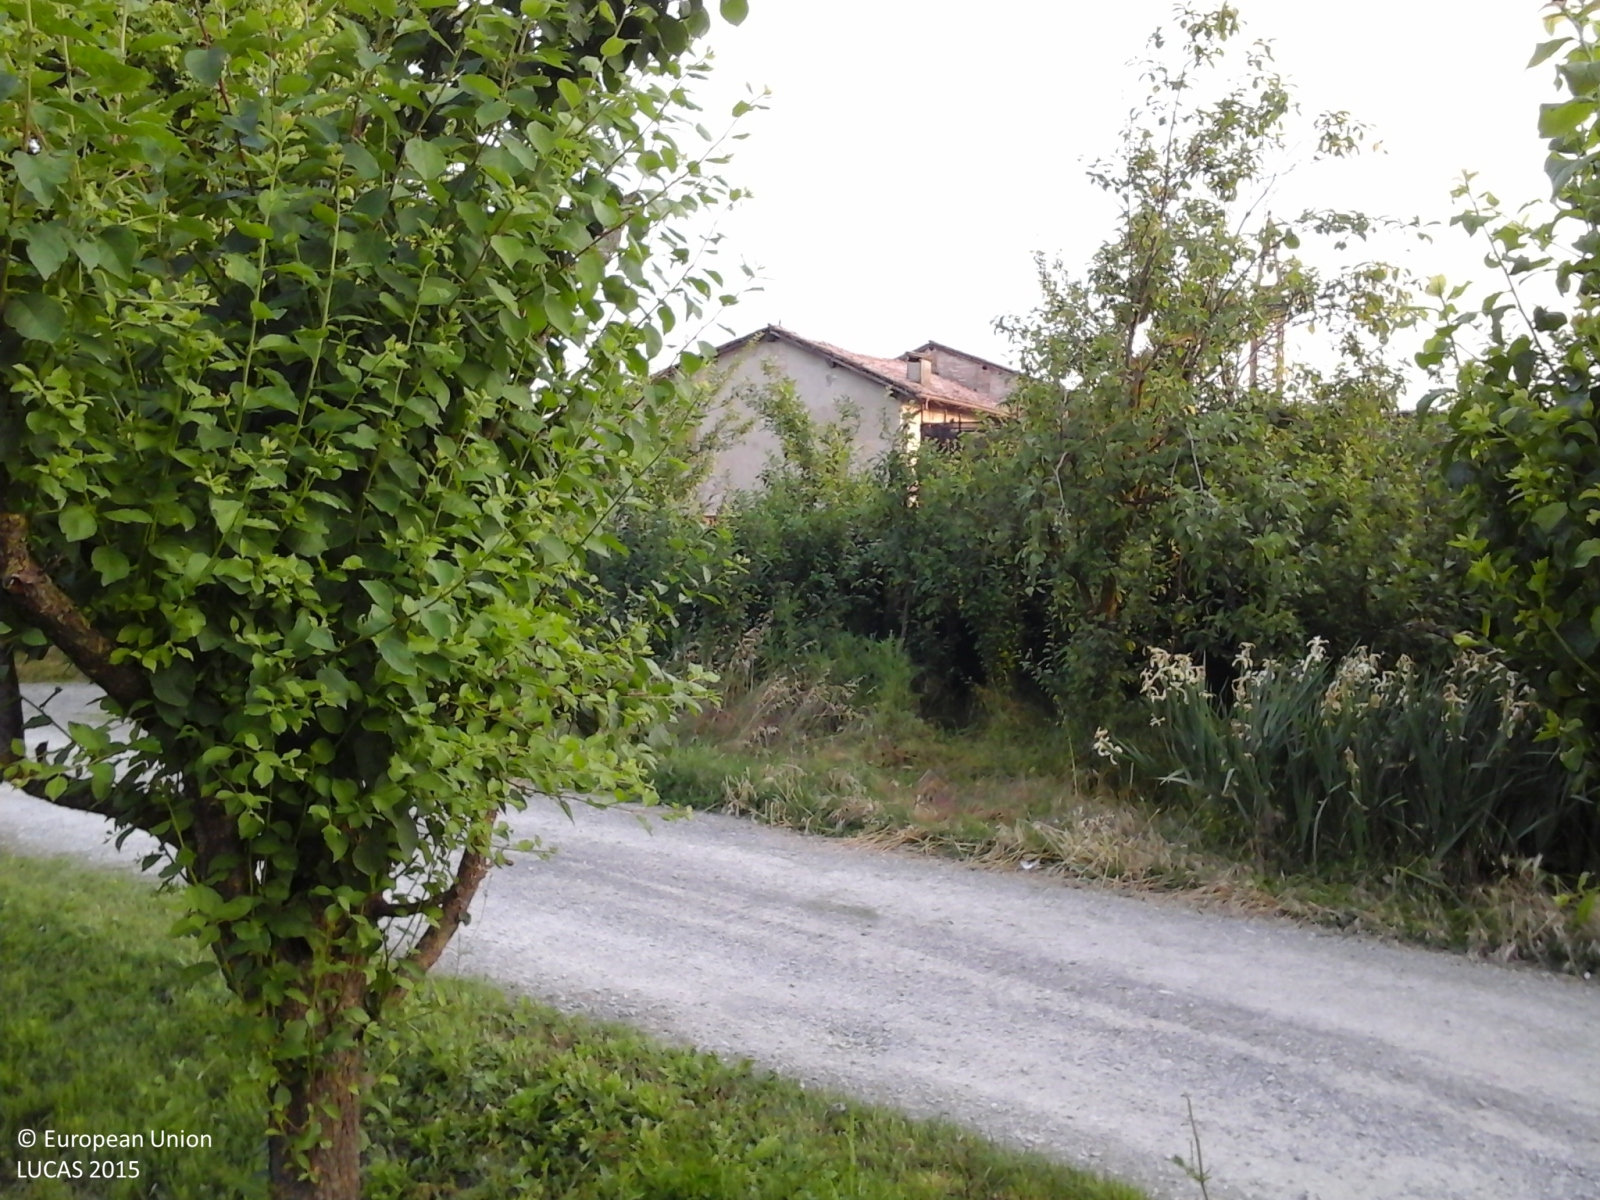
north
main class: Grassland
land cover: Grassland with sparse tree/shrub cover
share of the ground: > 75 %
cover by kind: herbaceous plants 95 %, broadleaved forest trees 5 %
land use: Agriculture (excluding fallow land and kitchen gardens)
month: May
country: IT
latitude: 44.8734
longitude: 10.1642
